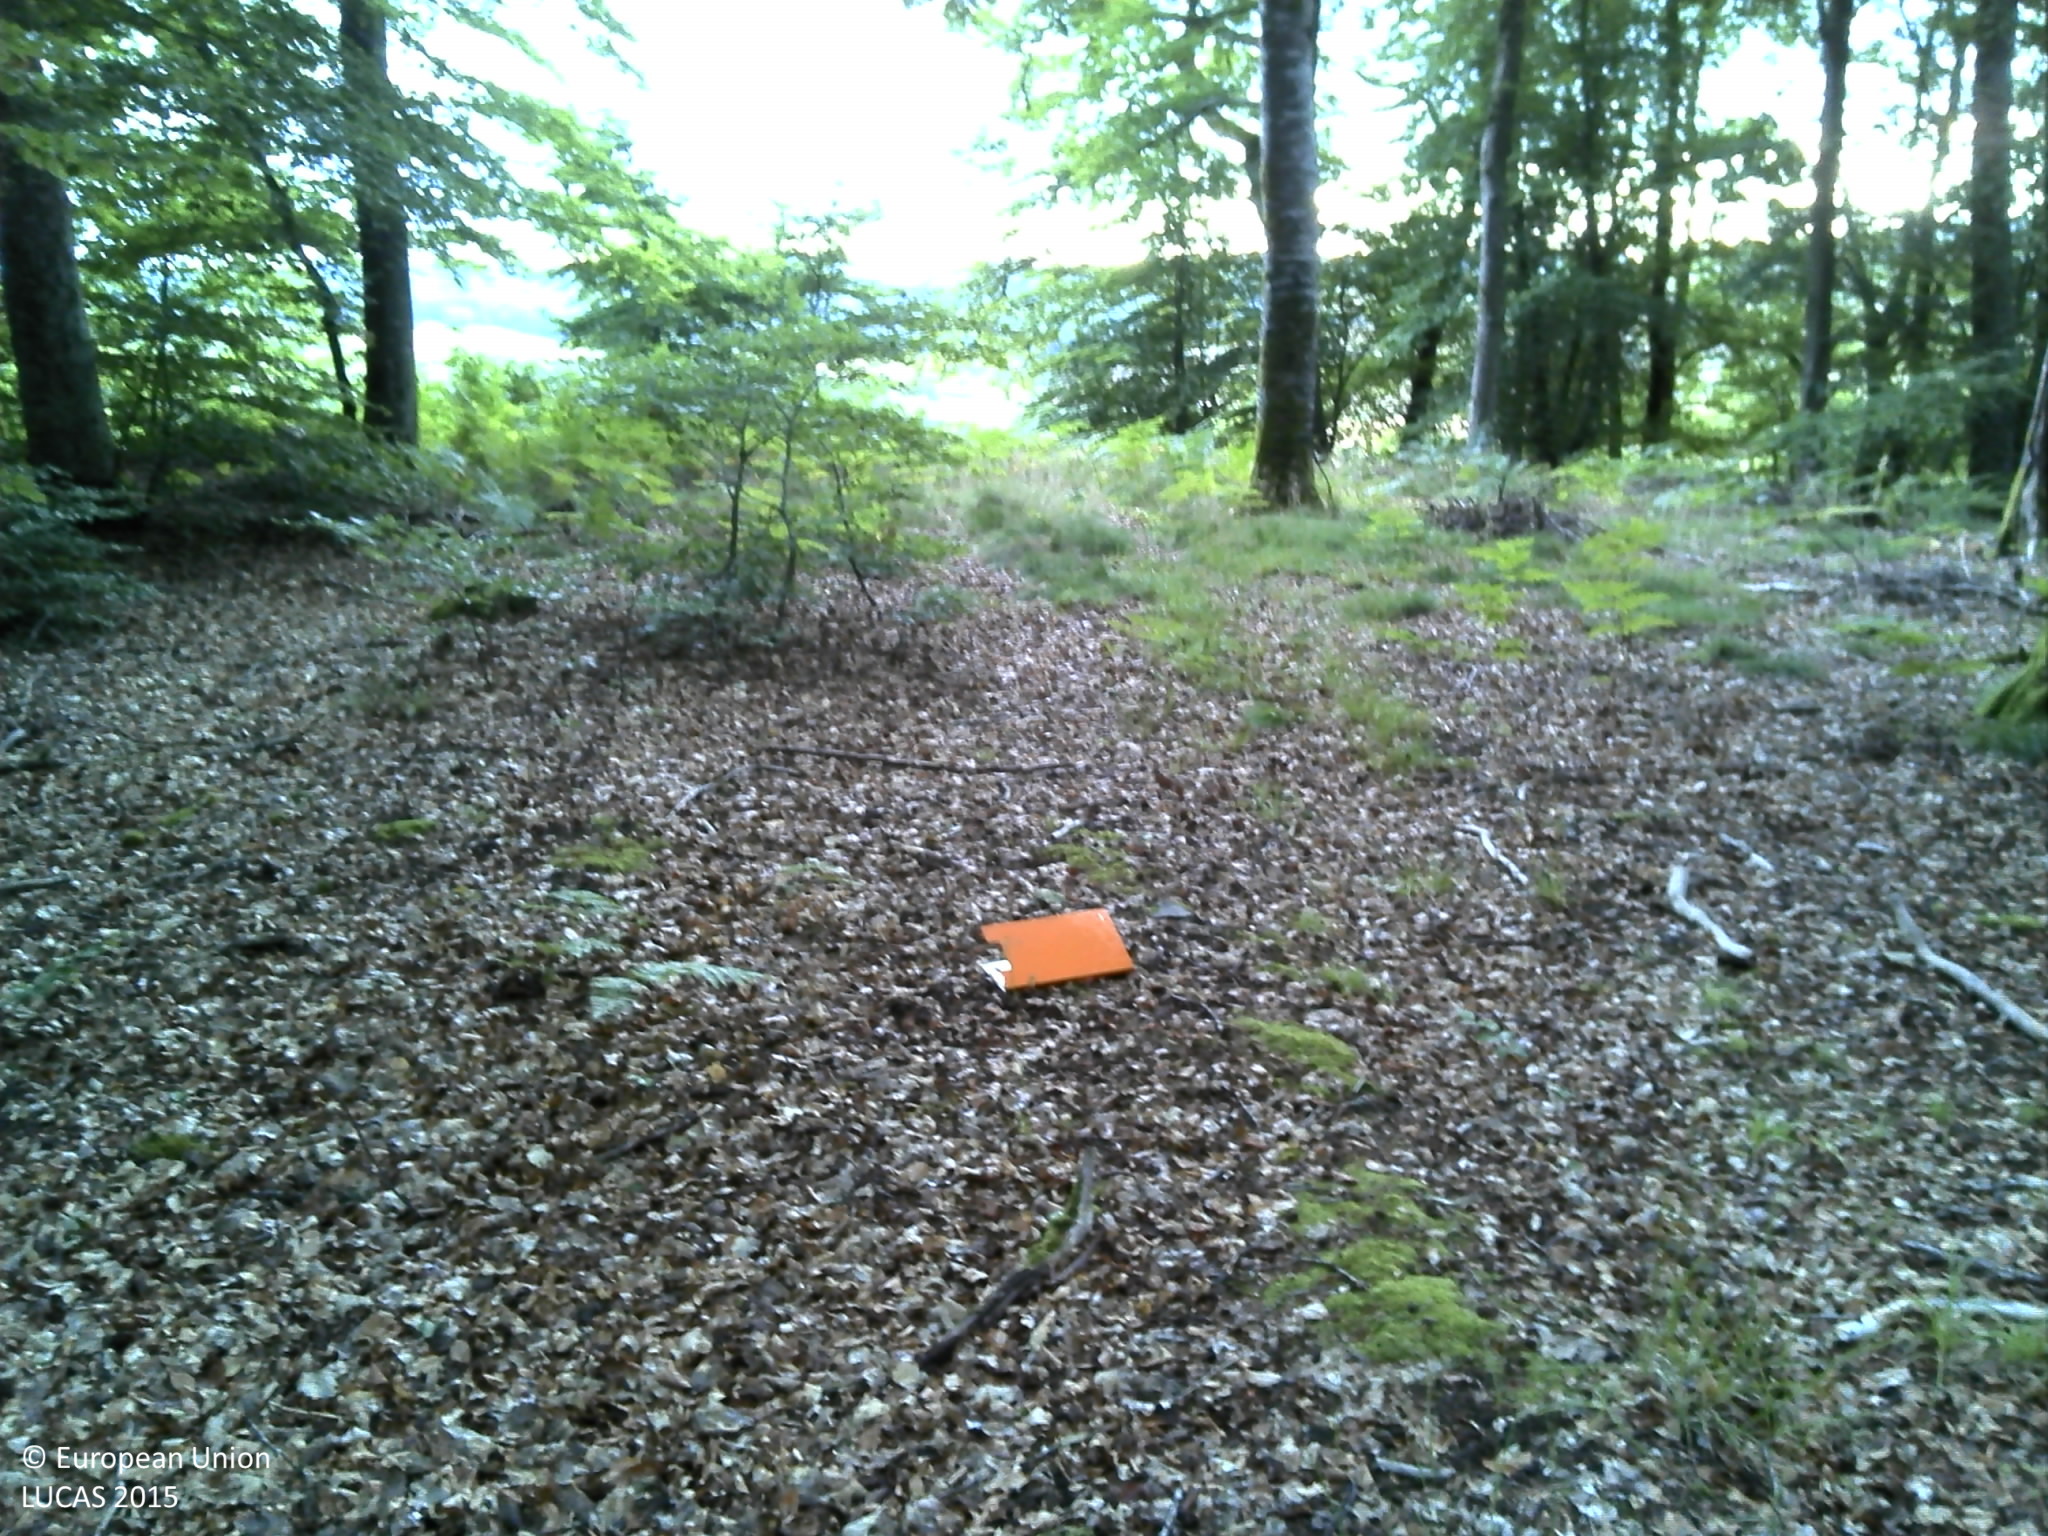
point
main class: Woodland
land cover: Broadleaved woodland
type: beech forest
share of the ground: > 75 %
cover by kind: broadleaved forest trees 80 %, unconsolidated bare surface 20 %
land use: Forestry
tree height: > 5 m
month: July
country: FR
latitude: 48.2505
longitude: 6.2699
